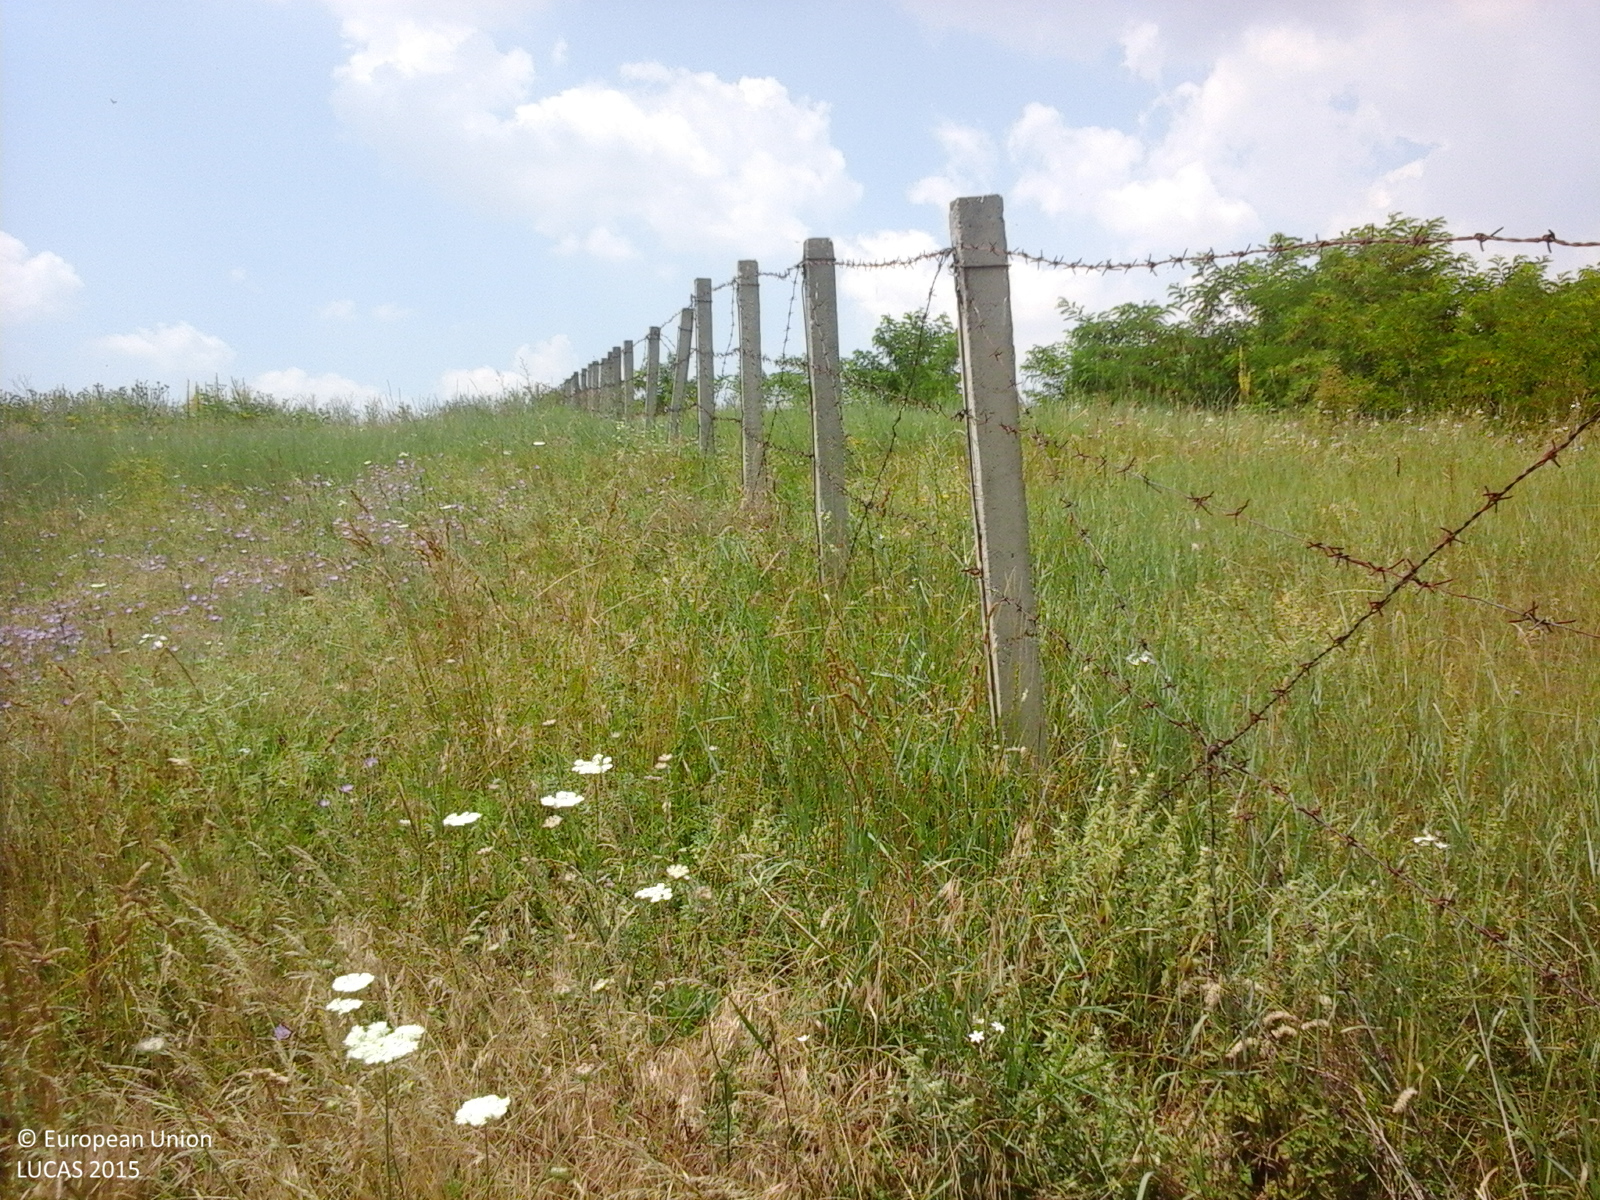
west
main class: Grassland
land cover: Grassland without tree/shrub cover
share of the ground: > 75 %
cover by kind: herbaceous plants 100 %
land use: Agriculture (excluding fallow land and kitchen gardens)
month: July
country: RO
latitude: 43.8194
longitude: 25.1338
